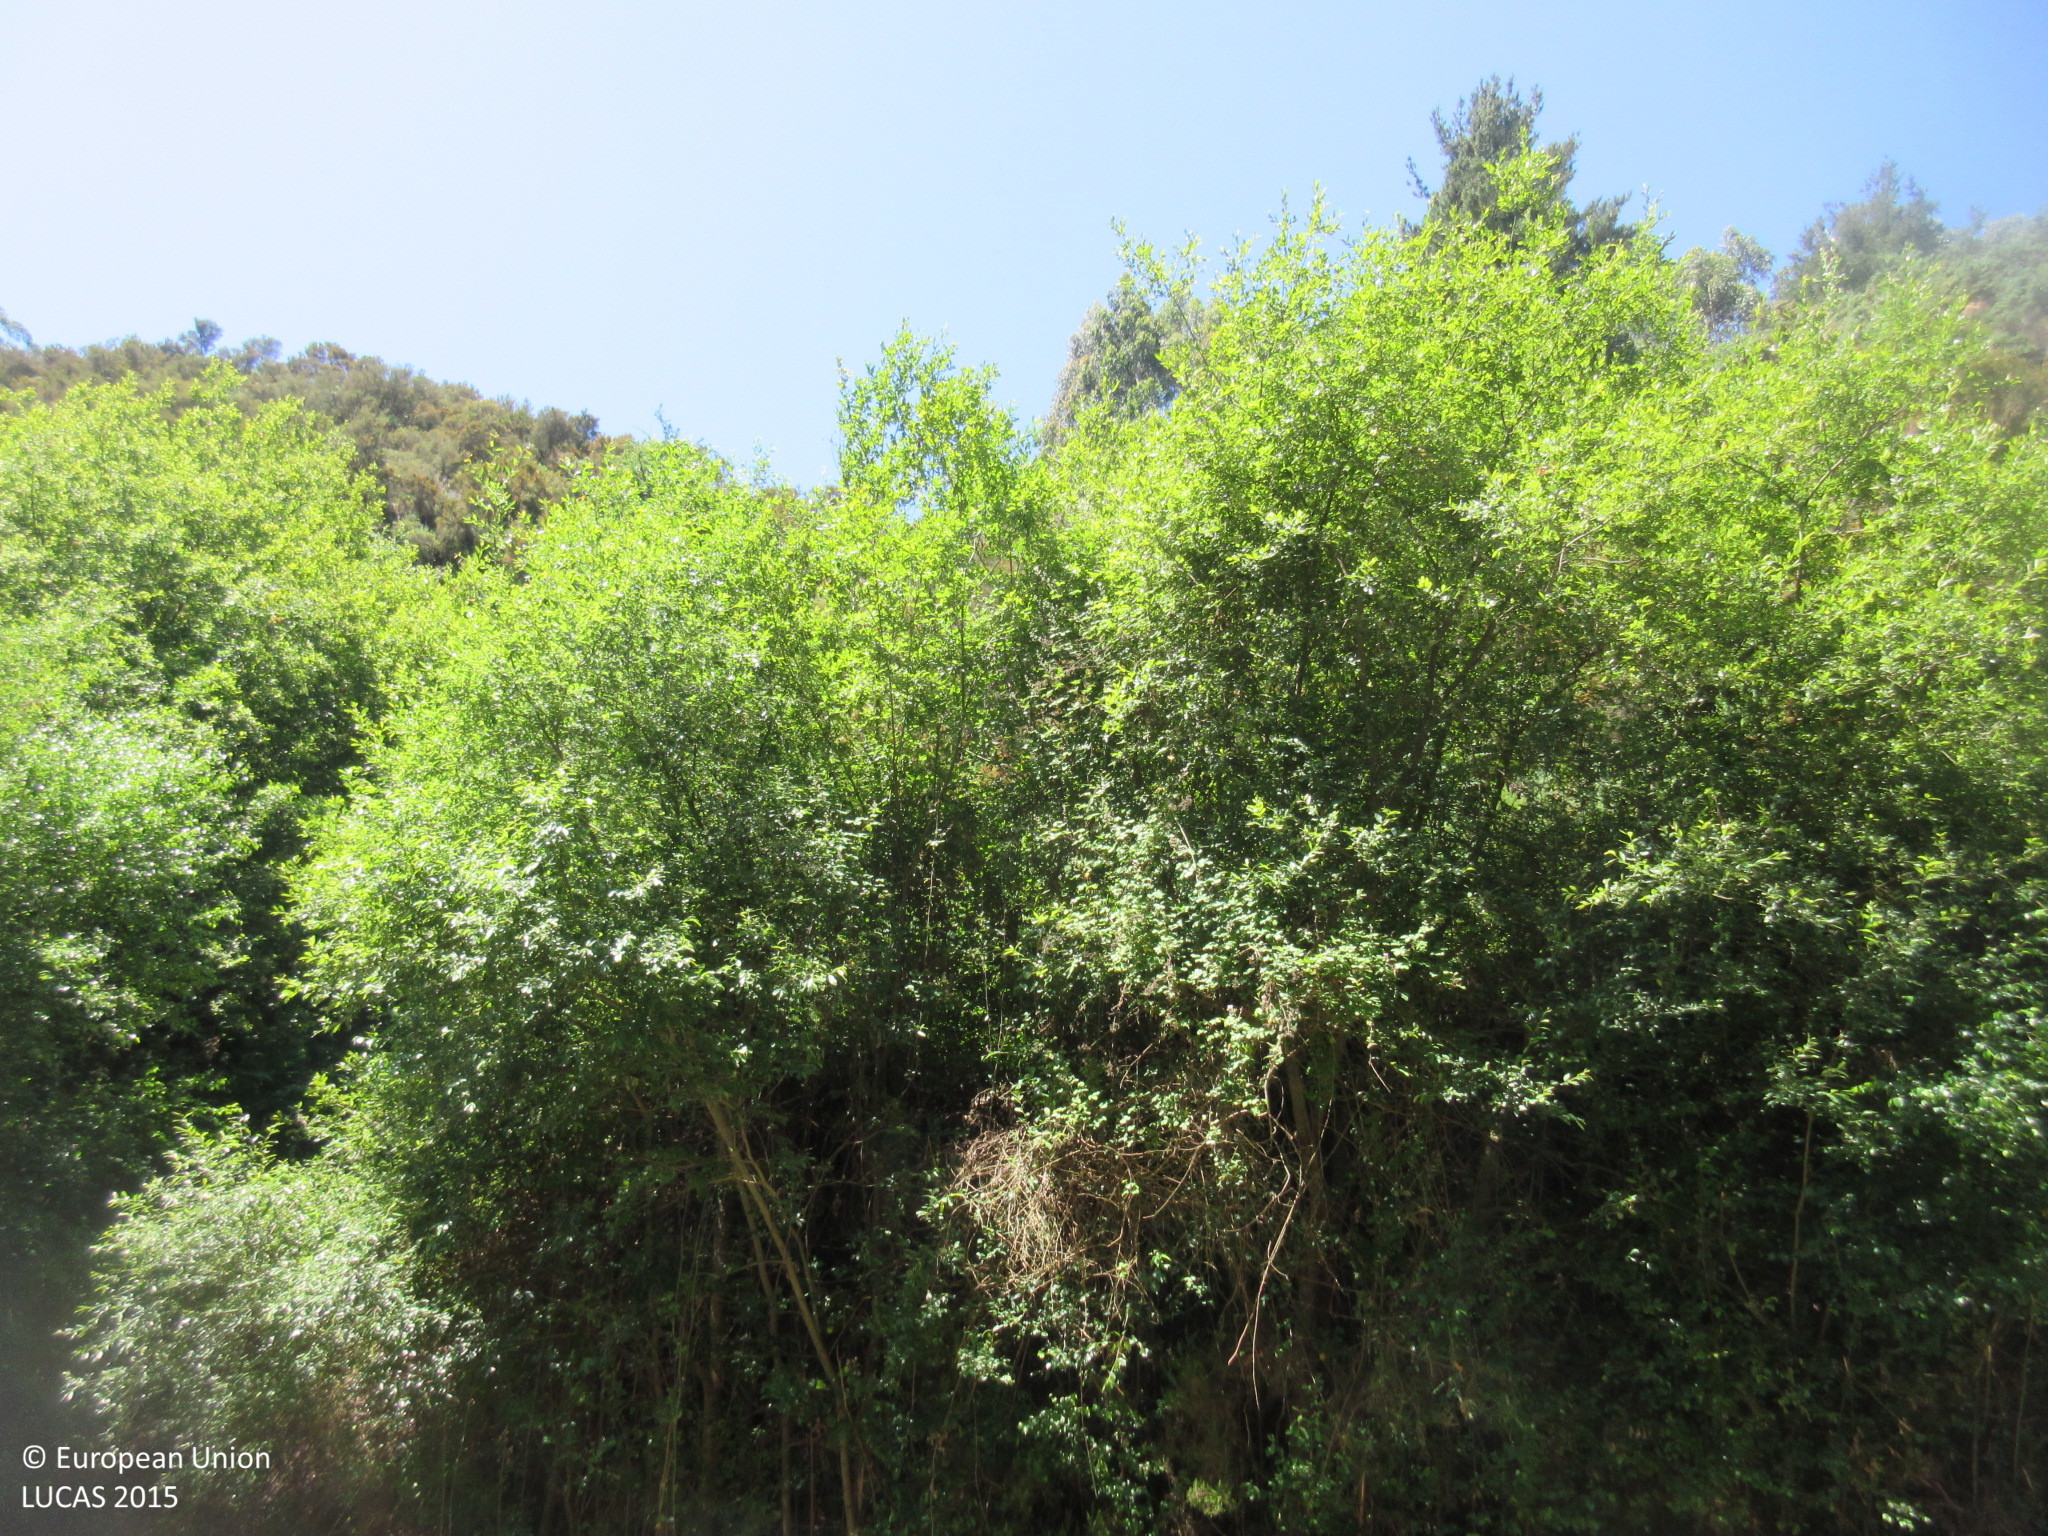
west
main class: Woodland
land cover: Broadleaved woodland
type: exotic forest
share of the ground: > 75 %
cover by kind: broadleaved forest trees 95 %, shrubs 5 %
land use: Forestry
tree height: > 5 m
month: June
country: ES
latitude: 43.2113
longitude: -7.2168
